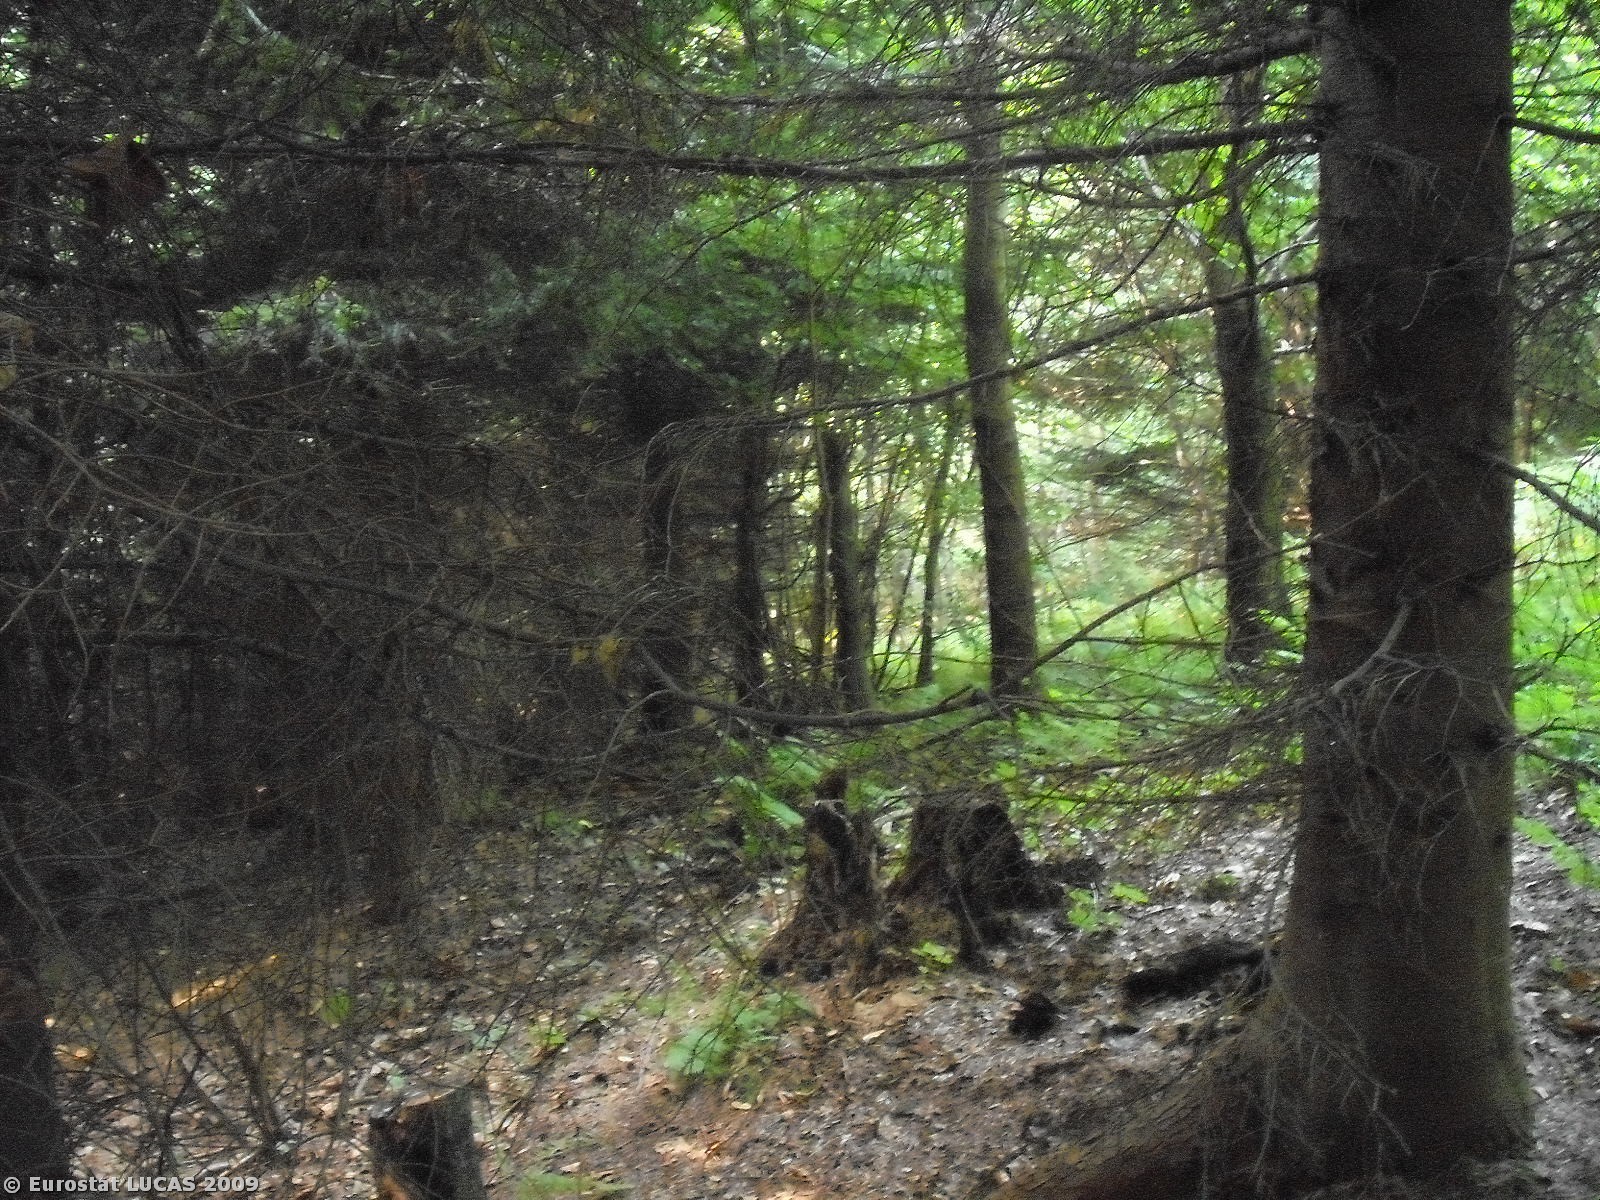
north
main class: Woodland
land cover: Mixed woodland
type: hemiboreal forest and nemoral coniferous forest and mixed broadleaved-coniferous forest
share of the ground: > 75 %
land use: Forestry
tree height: > 5 m
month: July
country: PL
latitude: 49.8982
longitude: 20.2954
